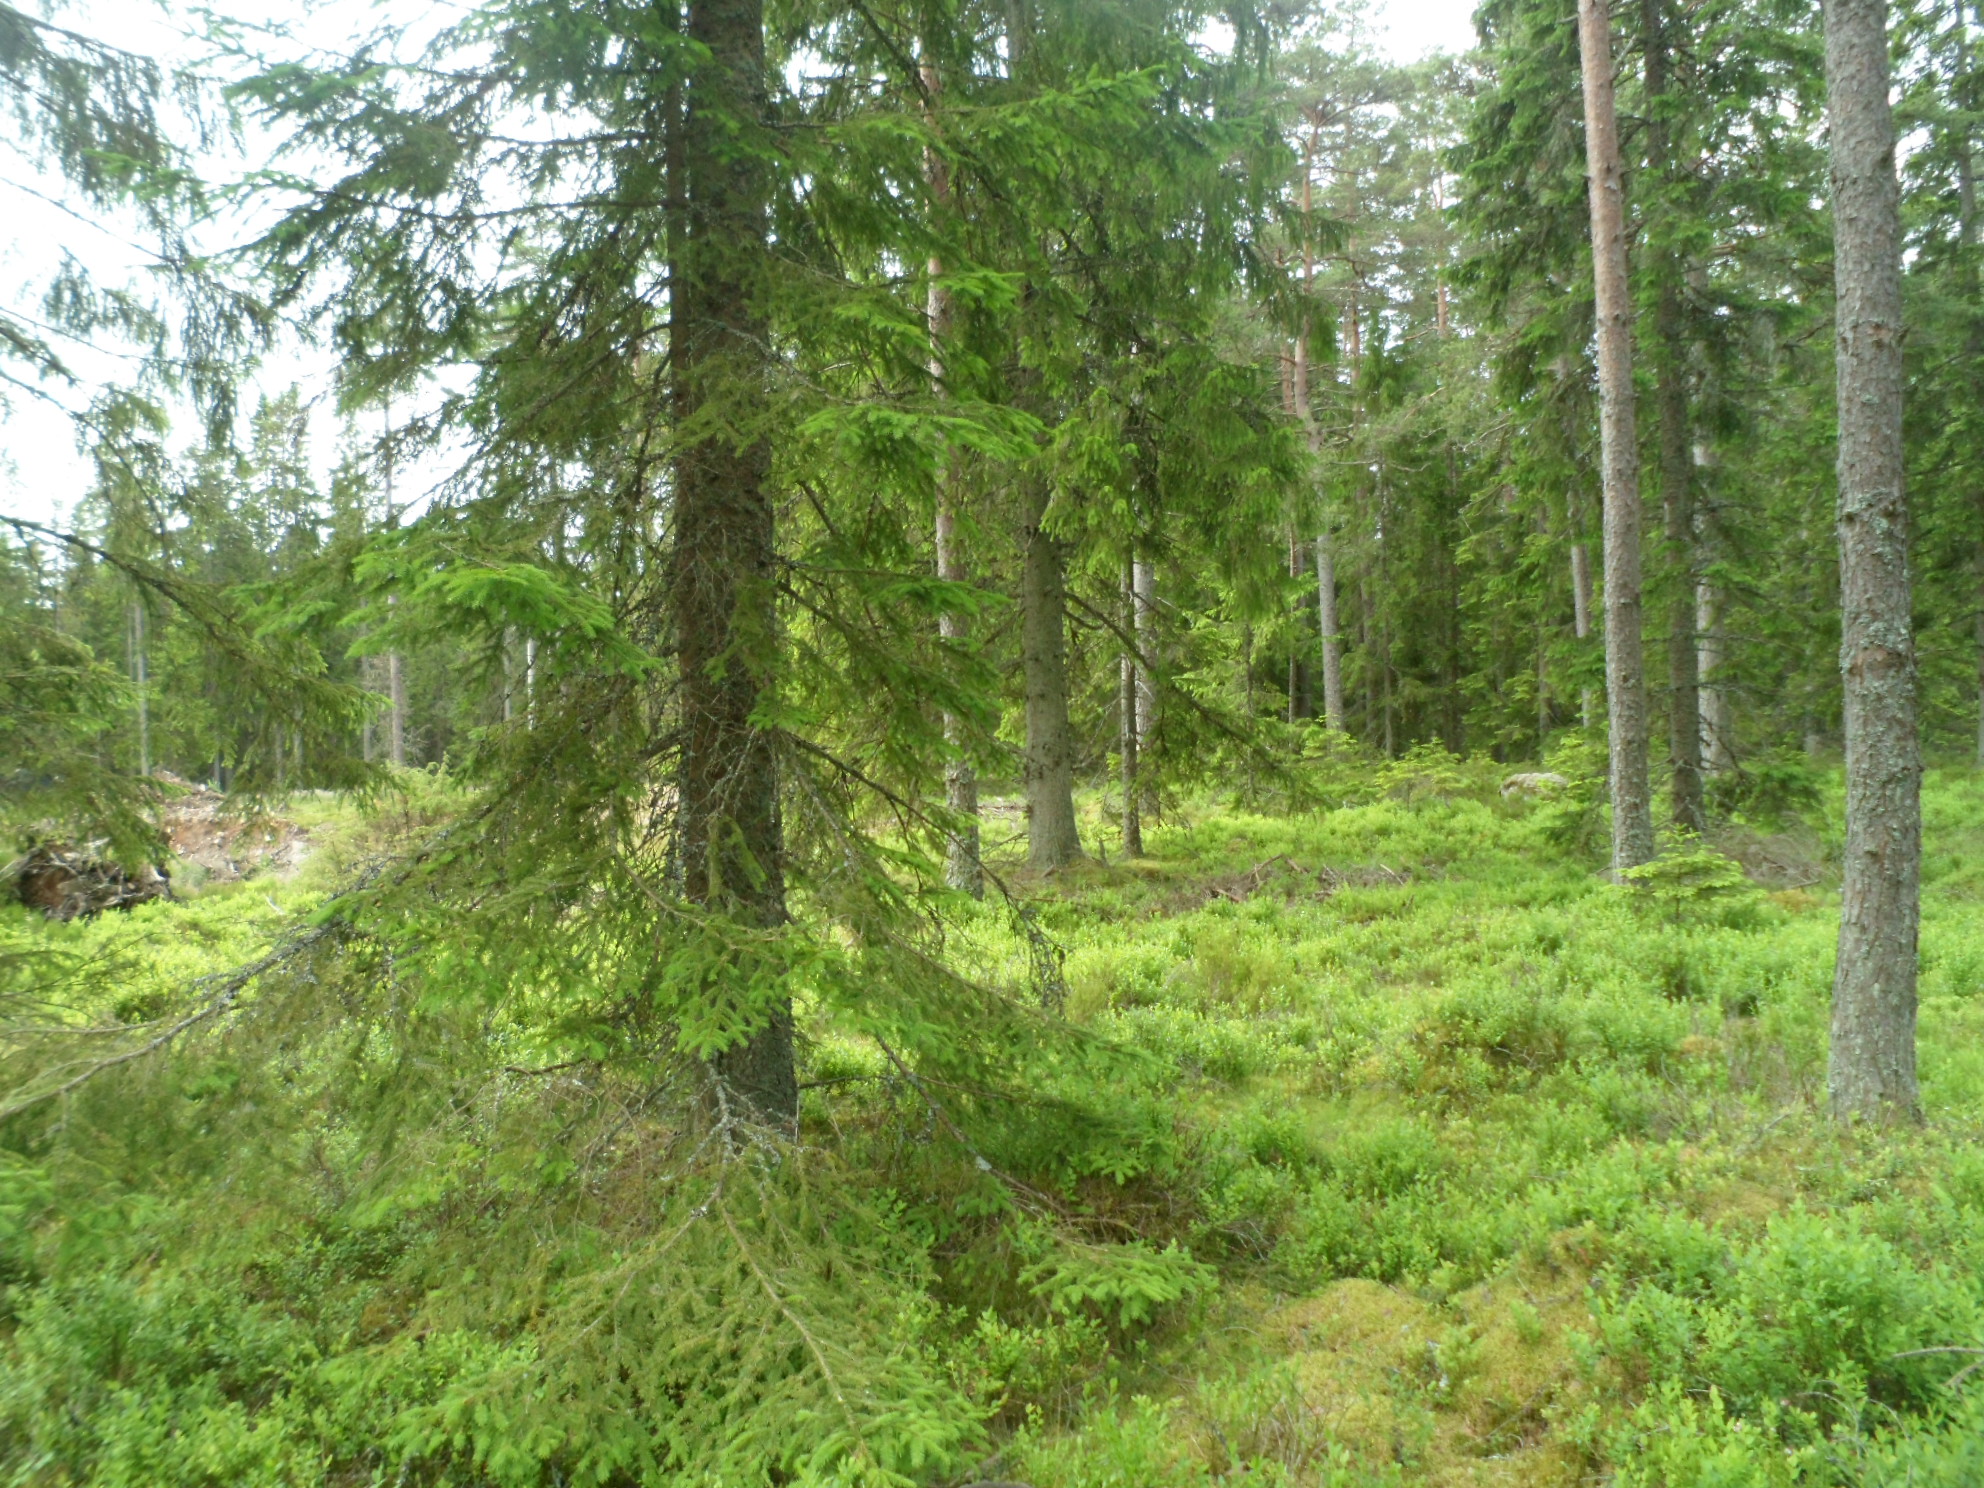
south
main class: Woodland
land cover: Pine dominated coniferous woodland
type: boreal forest
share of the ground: 50 - 75 %
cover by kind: coniferous forest trees 50 %, shrubs 30 %, lichens and mosses 15 %, herbaceous plants 5 %
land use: Forestry
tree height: > 5 m
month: June
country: SE
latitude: 57.0353
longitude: 15.2540
